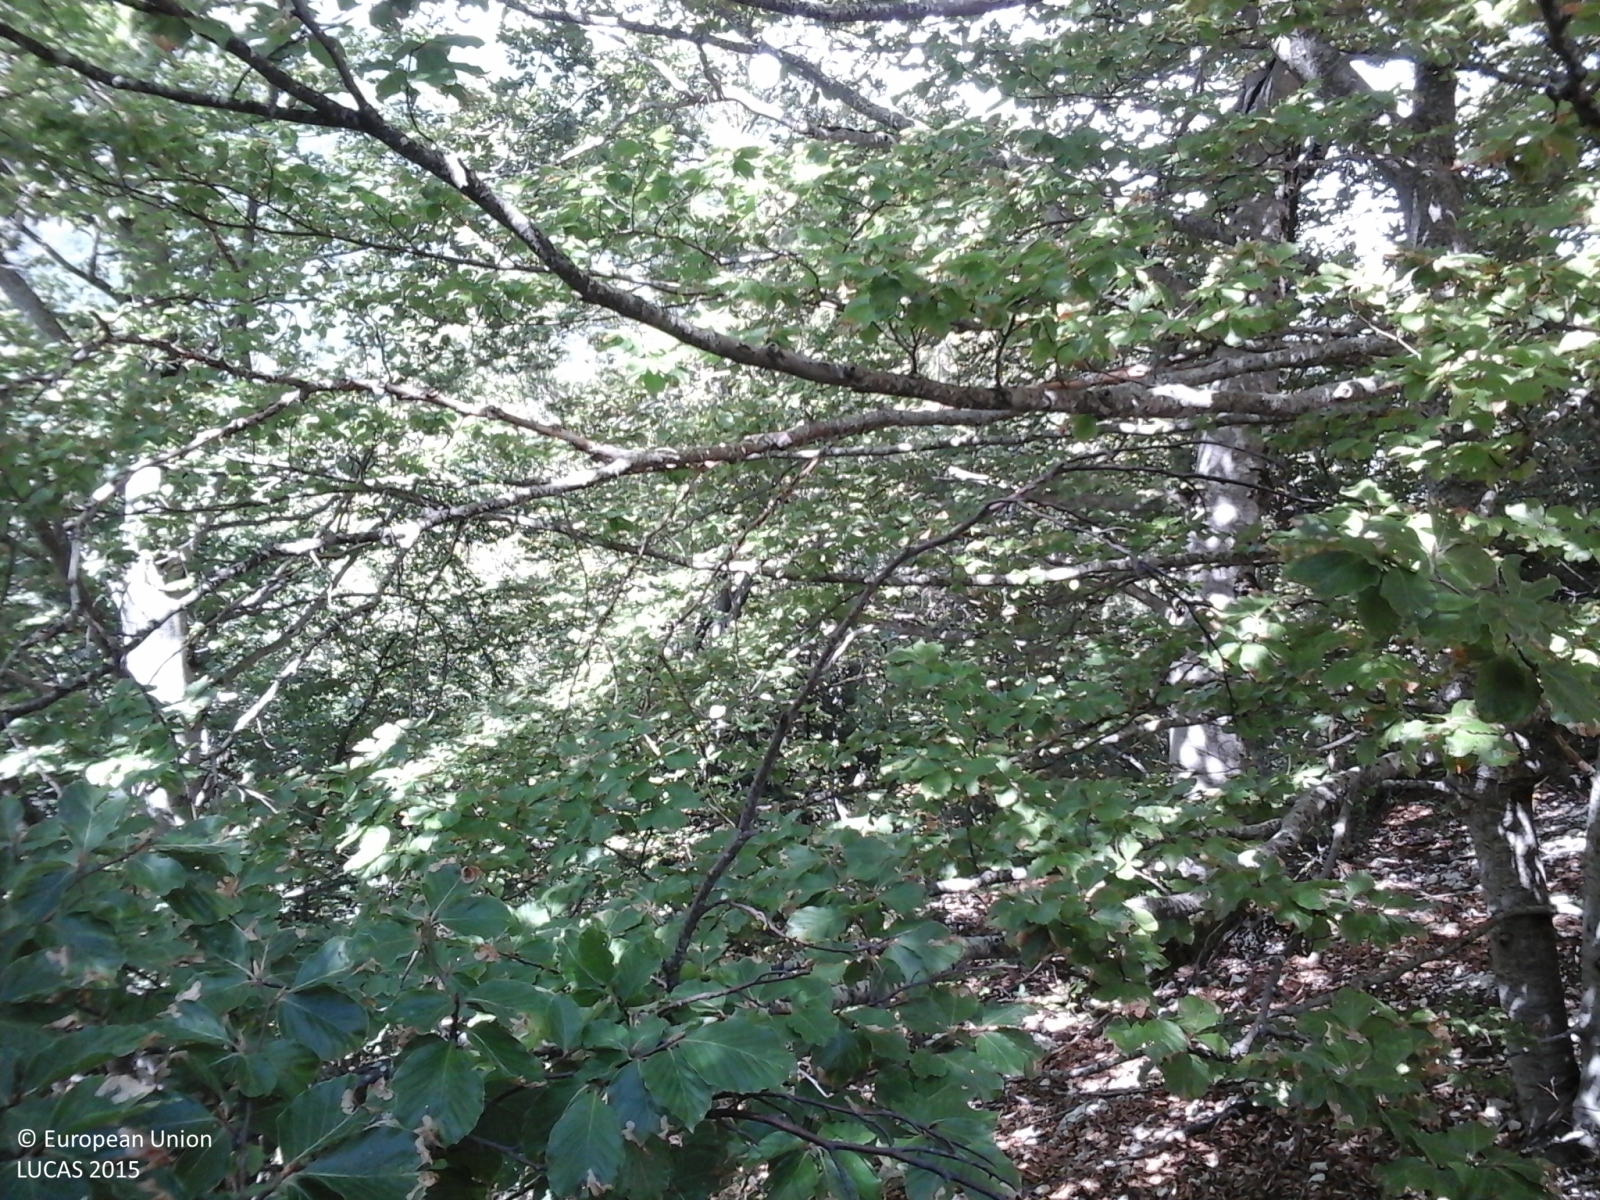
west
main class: Woodland
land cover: Broadleaved woodland
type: mountainous beech forest
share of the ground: > 75 %
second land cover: Grassland without tree/shrub cover
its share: < 10 %
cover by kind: broadleaved forest trees 90 %, herbaceous plants 10 %
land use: Forestry
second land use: Agriculture (excluding fallow land and kitchen gardens)
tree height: > 5 m
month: August
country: IT
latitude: 42.8577
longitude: 13.1605
